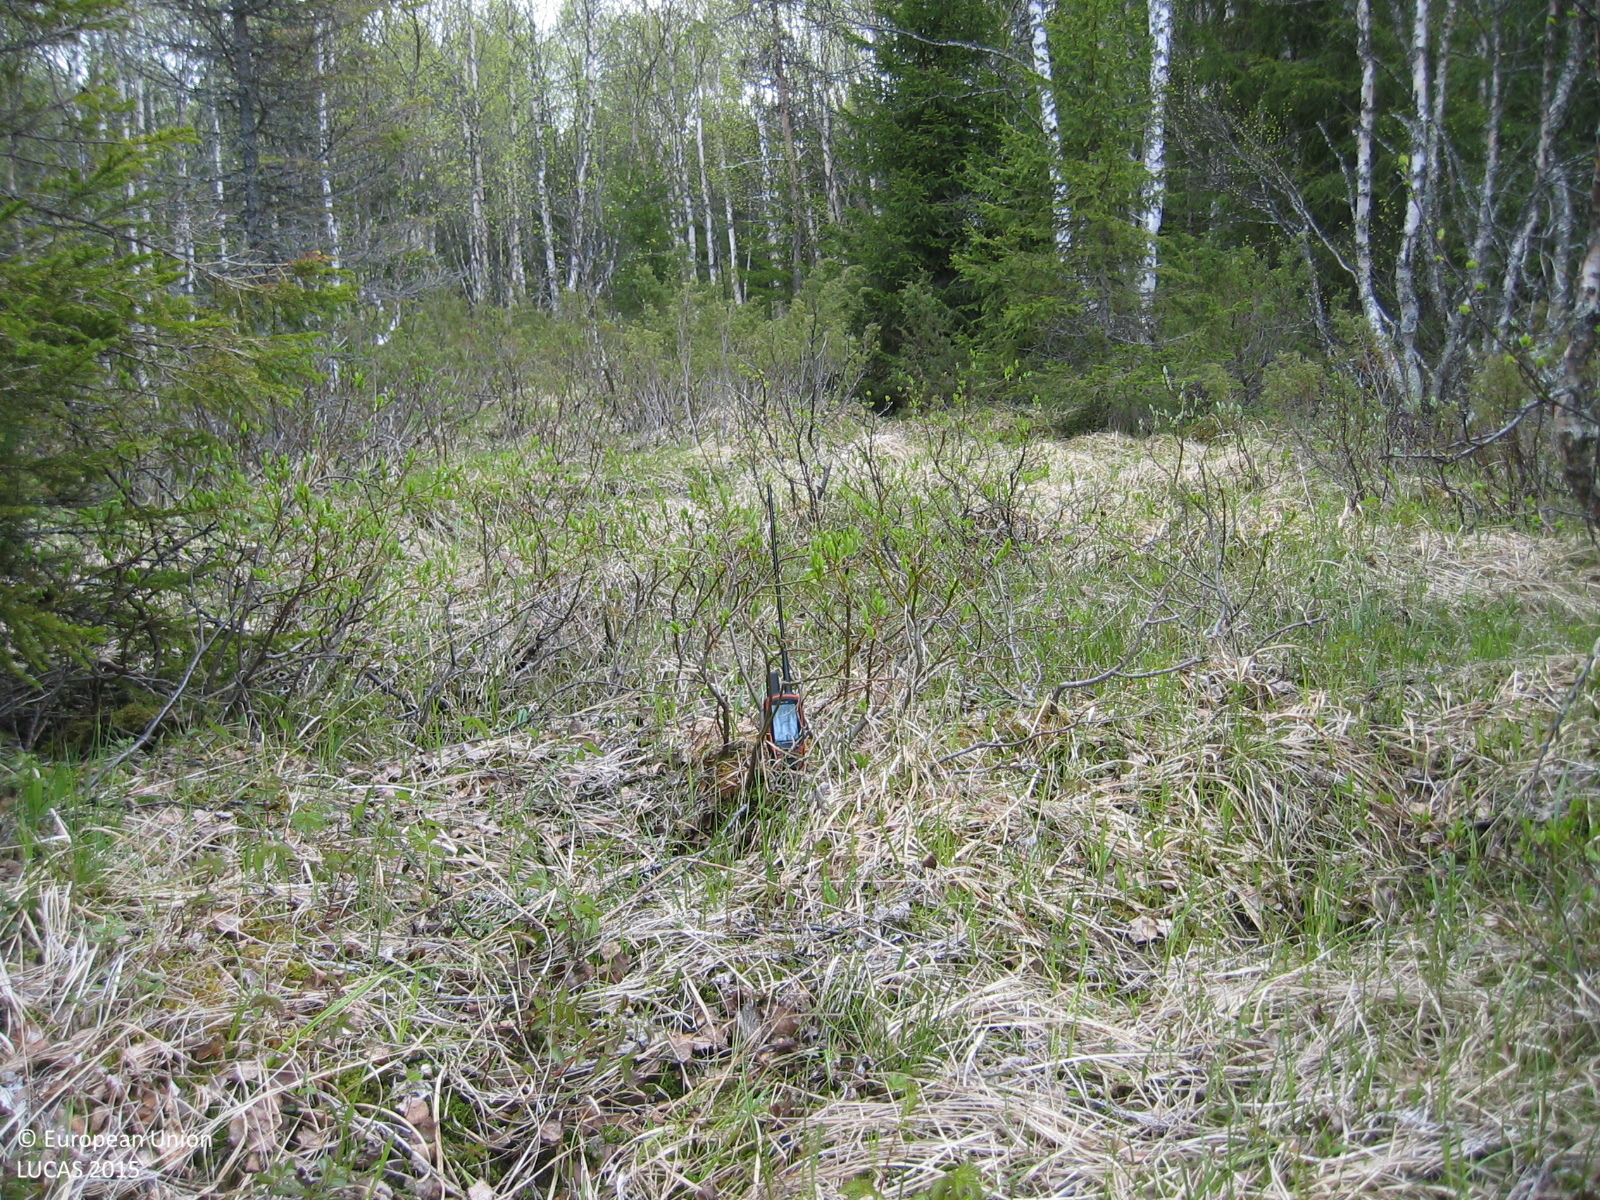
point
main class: Woodland
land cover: Spruce dominated mixed woodland
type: boreal forest
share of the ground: 50 - 75 %
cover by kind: coniferous forest trees 45 %, shrubs 20 %, herbaceous plants 20 %, broadleaved forest trees 15 %
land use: Forestry
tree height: > 5 m
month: June
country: SE
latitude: 63.5549
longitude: 13.9045
